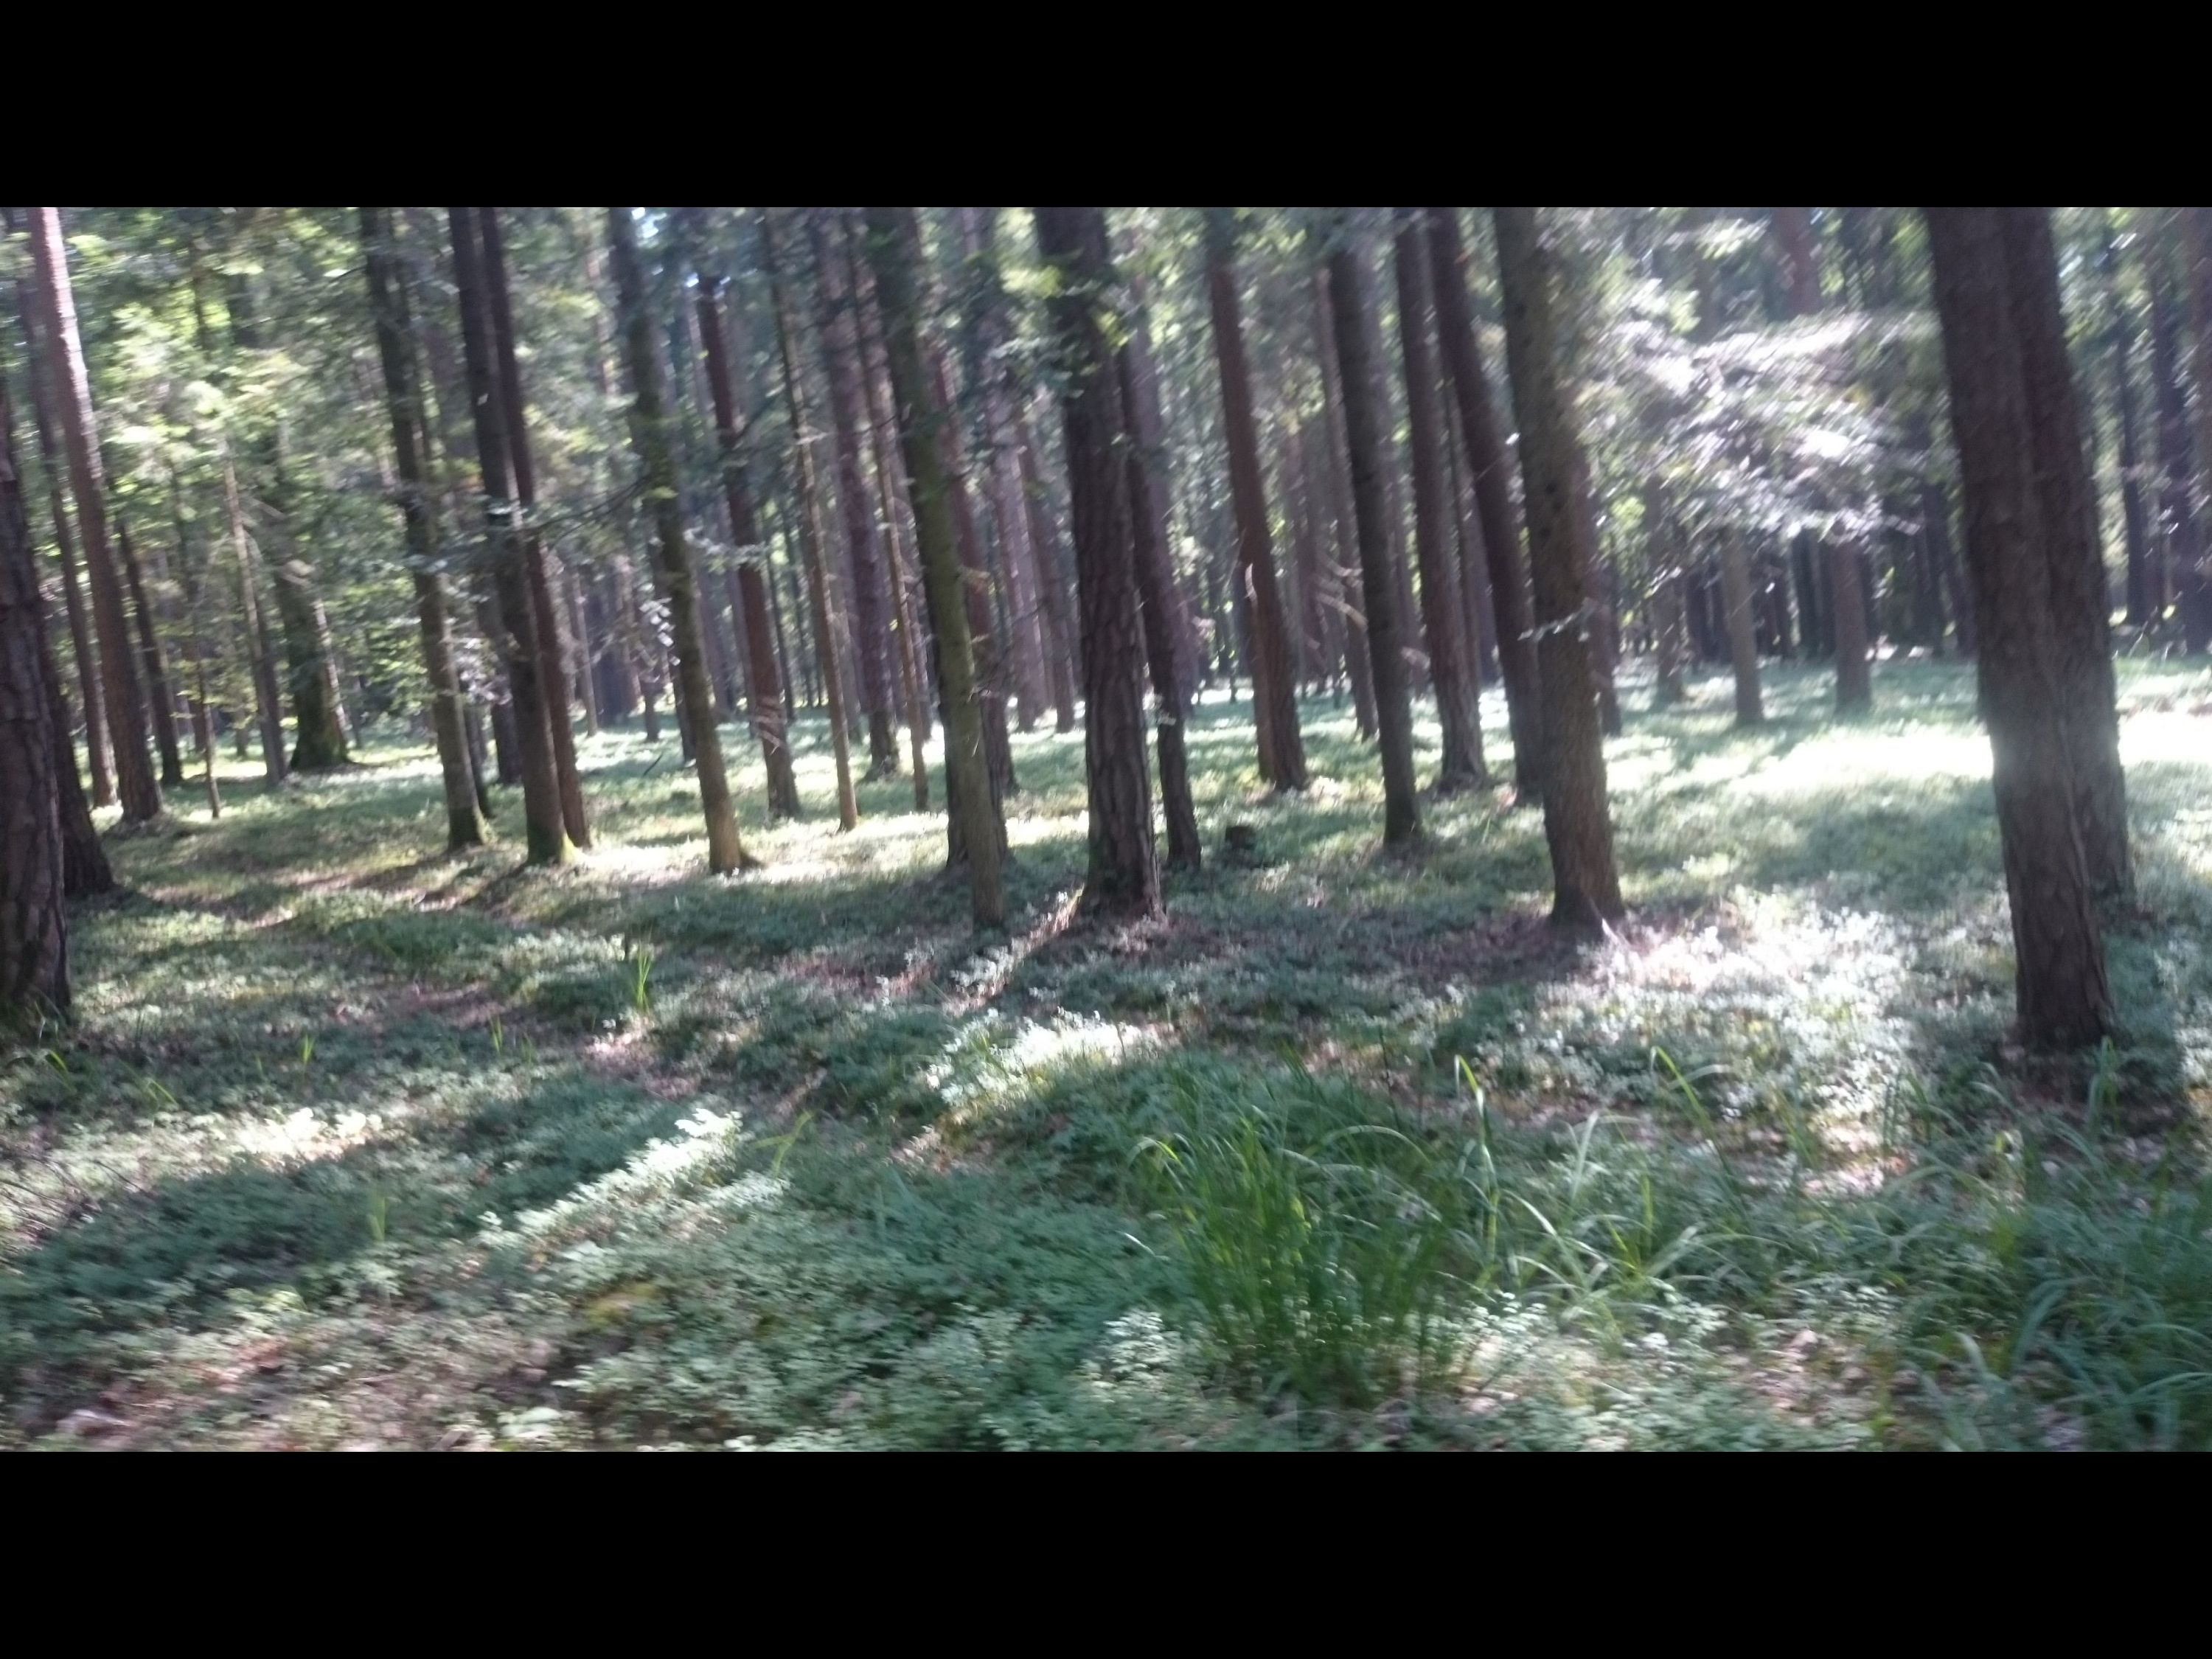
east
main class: Woodland
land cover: Pine dominated coniferous woodland
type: hemiboreal forest and nemoral coniferous forest and mixed broadleaved-coniferous forest
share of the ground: > 75 %
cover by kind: coniferous forest trees 80 %, shrubs 10 %, herbaceous plants 10 %
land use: Forestry
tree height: > 5 m
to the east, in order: Pine dominated coniferous woodland; Tracks; Pine dominated coniferous woodland; Spruce dominated mixed woodland
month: July
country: AT
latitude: 47.1232
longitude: 15.9724
